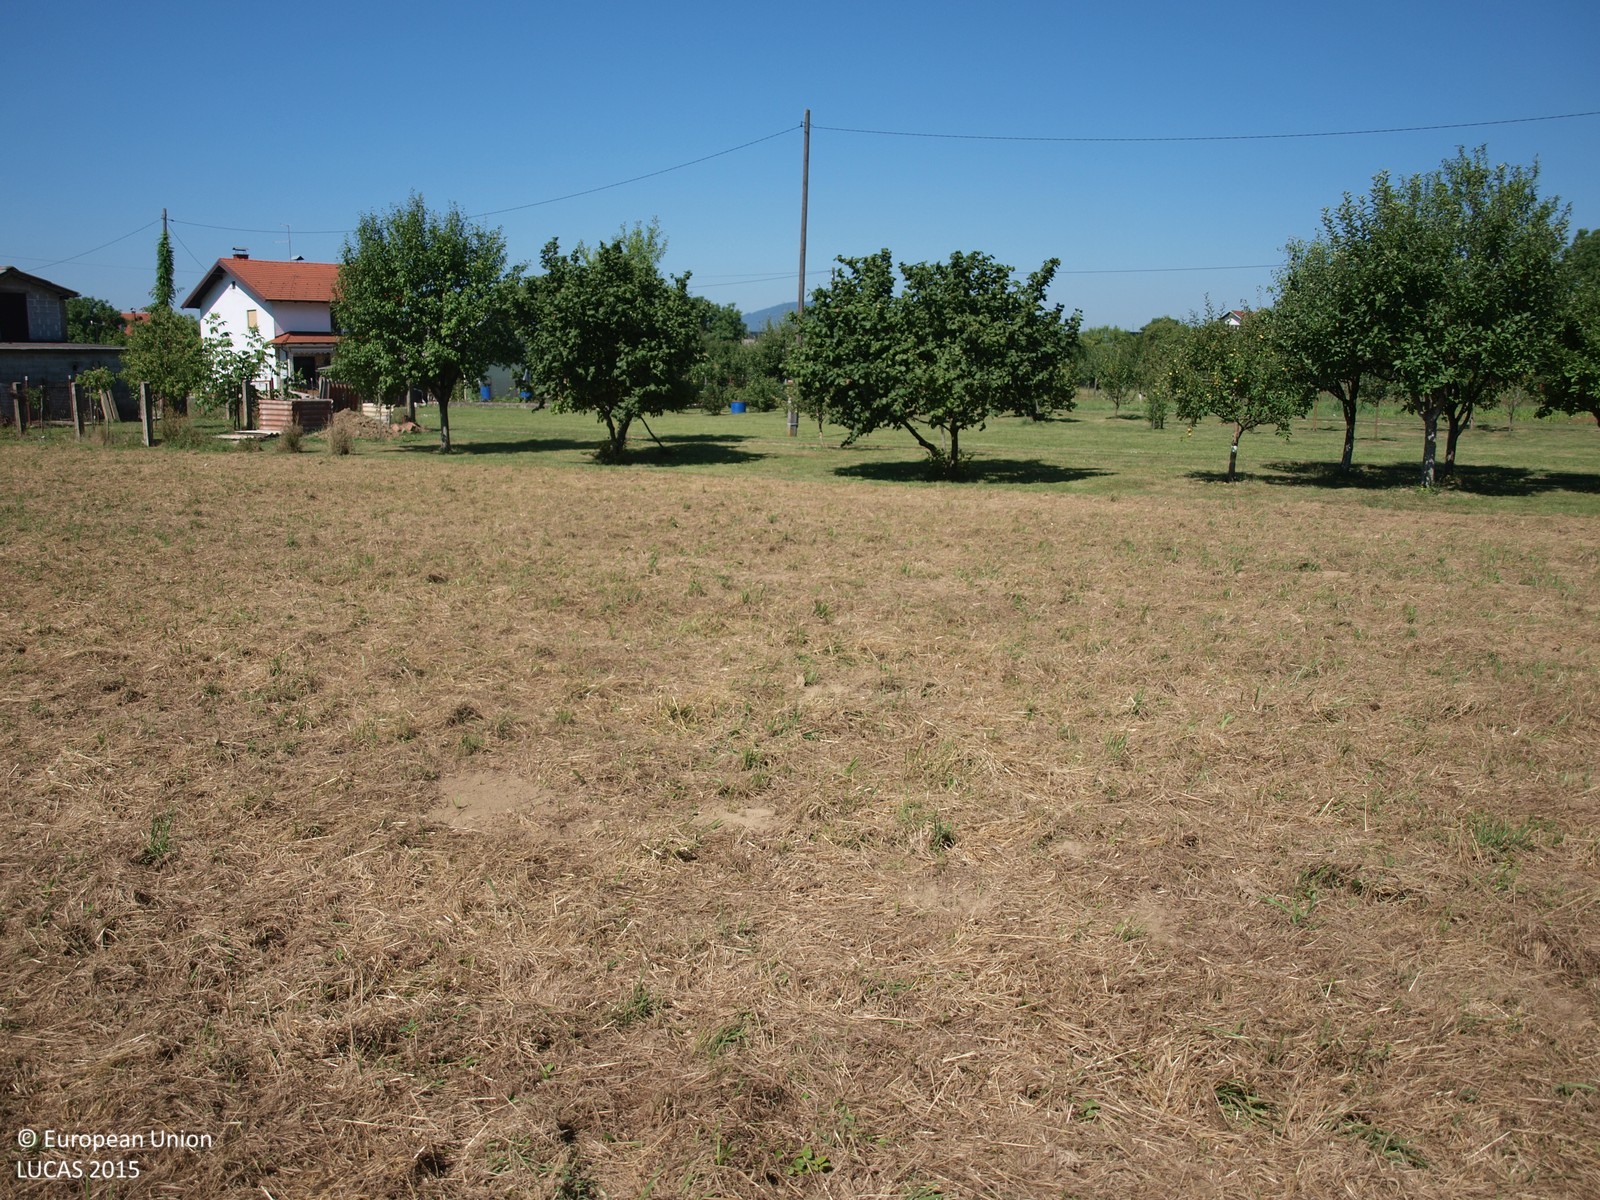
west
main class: Grassland
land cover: Grassland without tree/shrub cover
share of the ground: > 75 %
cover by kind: herbaceous plants 100 %
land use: Agriculture (excluding fallow land and kitchen gardens)
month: July
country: HR
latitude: 45.8712
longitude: 15.7561
